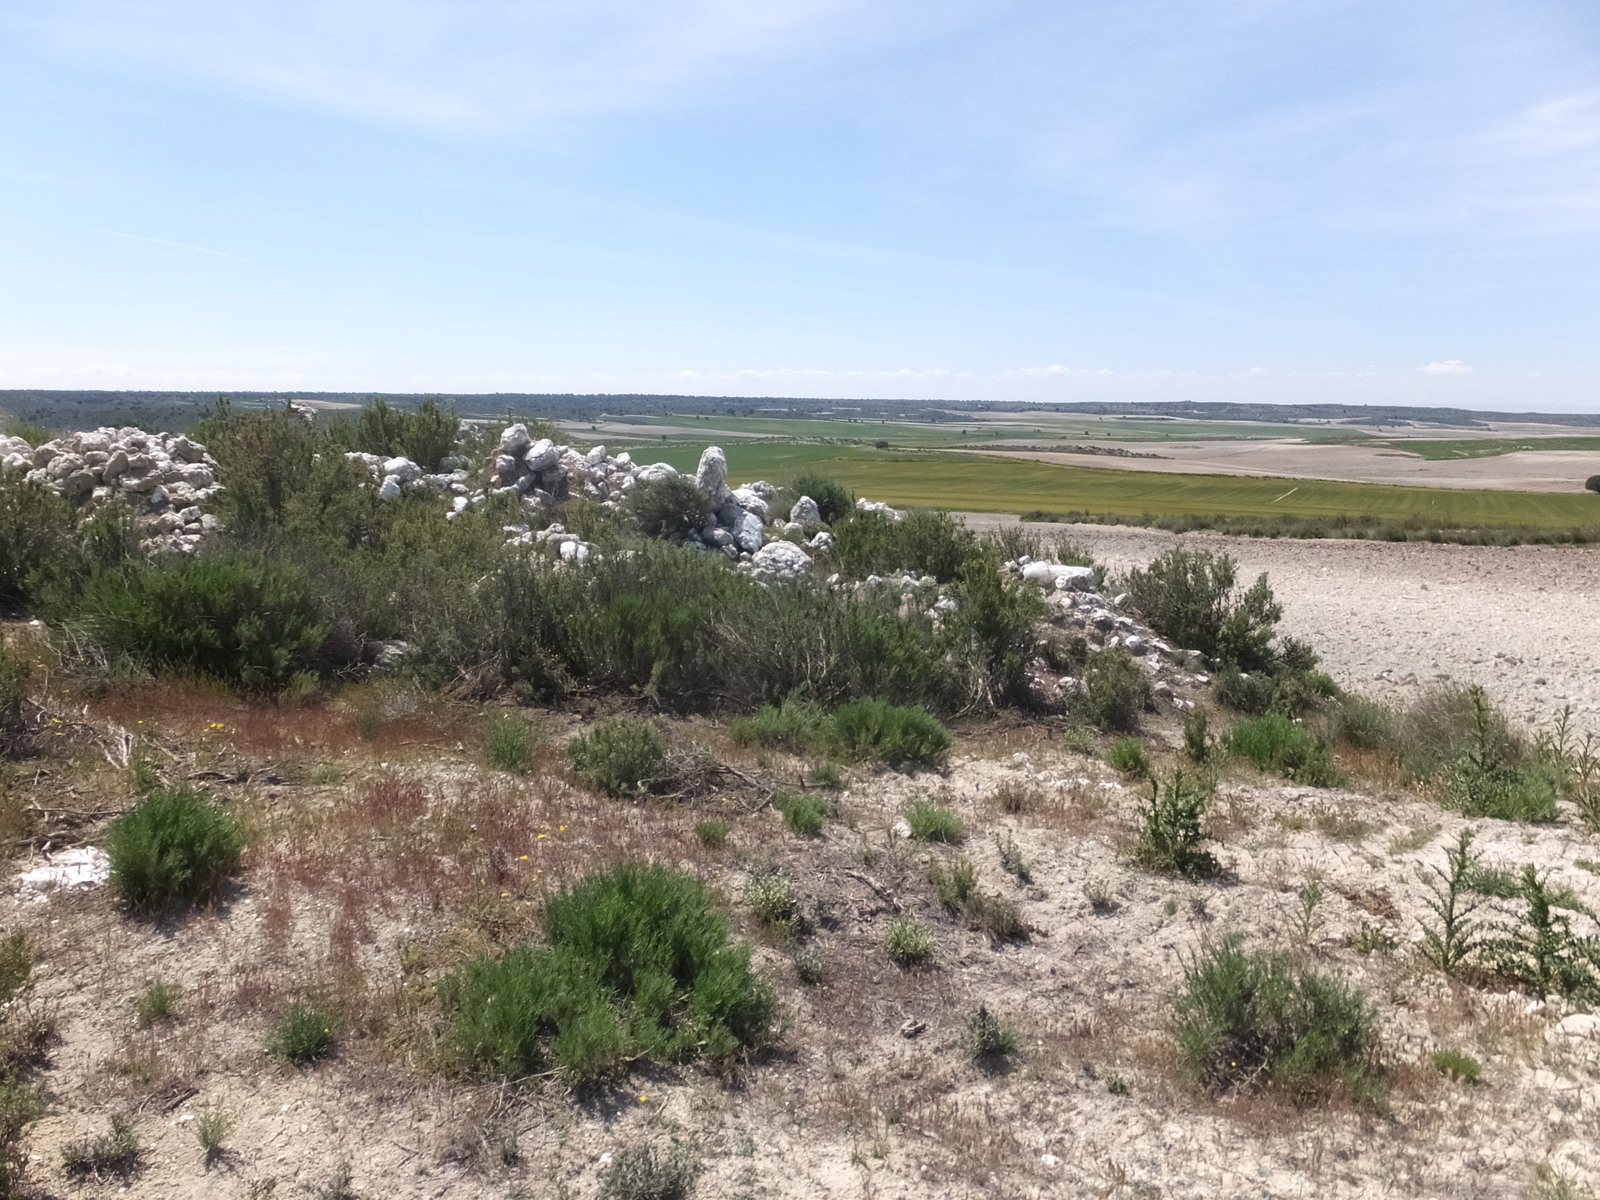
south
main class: Shrubland
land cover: Shrubland without tree cover
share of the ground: > 75 %
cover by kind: shrubs 50 %, herbaceous plants 25 %, consolidated bare surface 25 %
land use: Abandoned areas
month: April
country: ES
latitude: 41.5105
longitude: -0.2844
